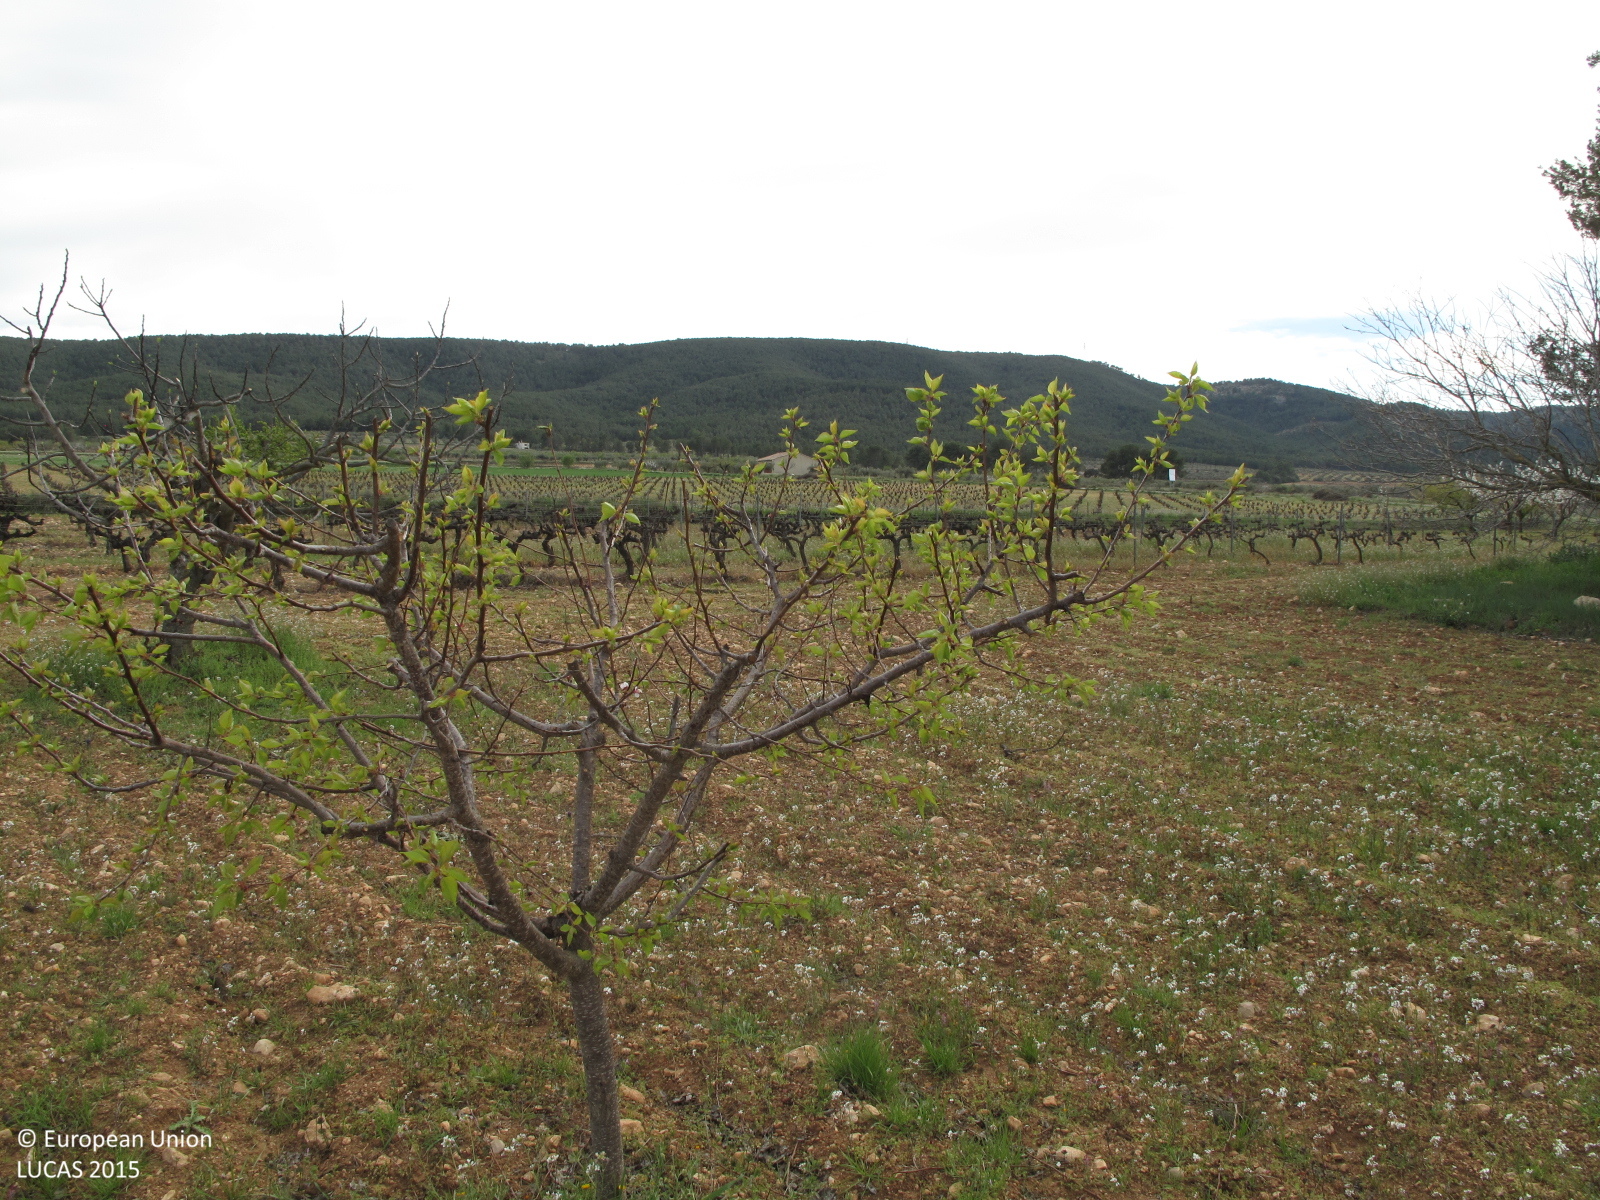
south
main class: Cropland
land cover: Cherry fruit
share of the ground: 10 - 25 %
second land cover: Other fruit trees and berries
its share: < 10 %
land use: Agriculture (excluding fallow land and kitchen gardens)
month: March
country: ES
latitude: 38.7802
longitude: -0.7544
